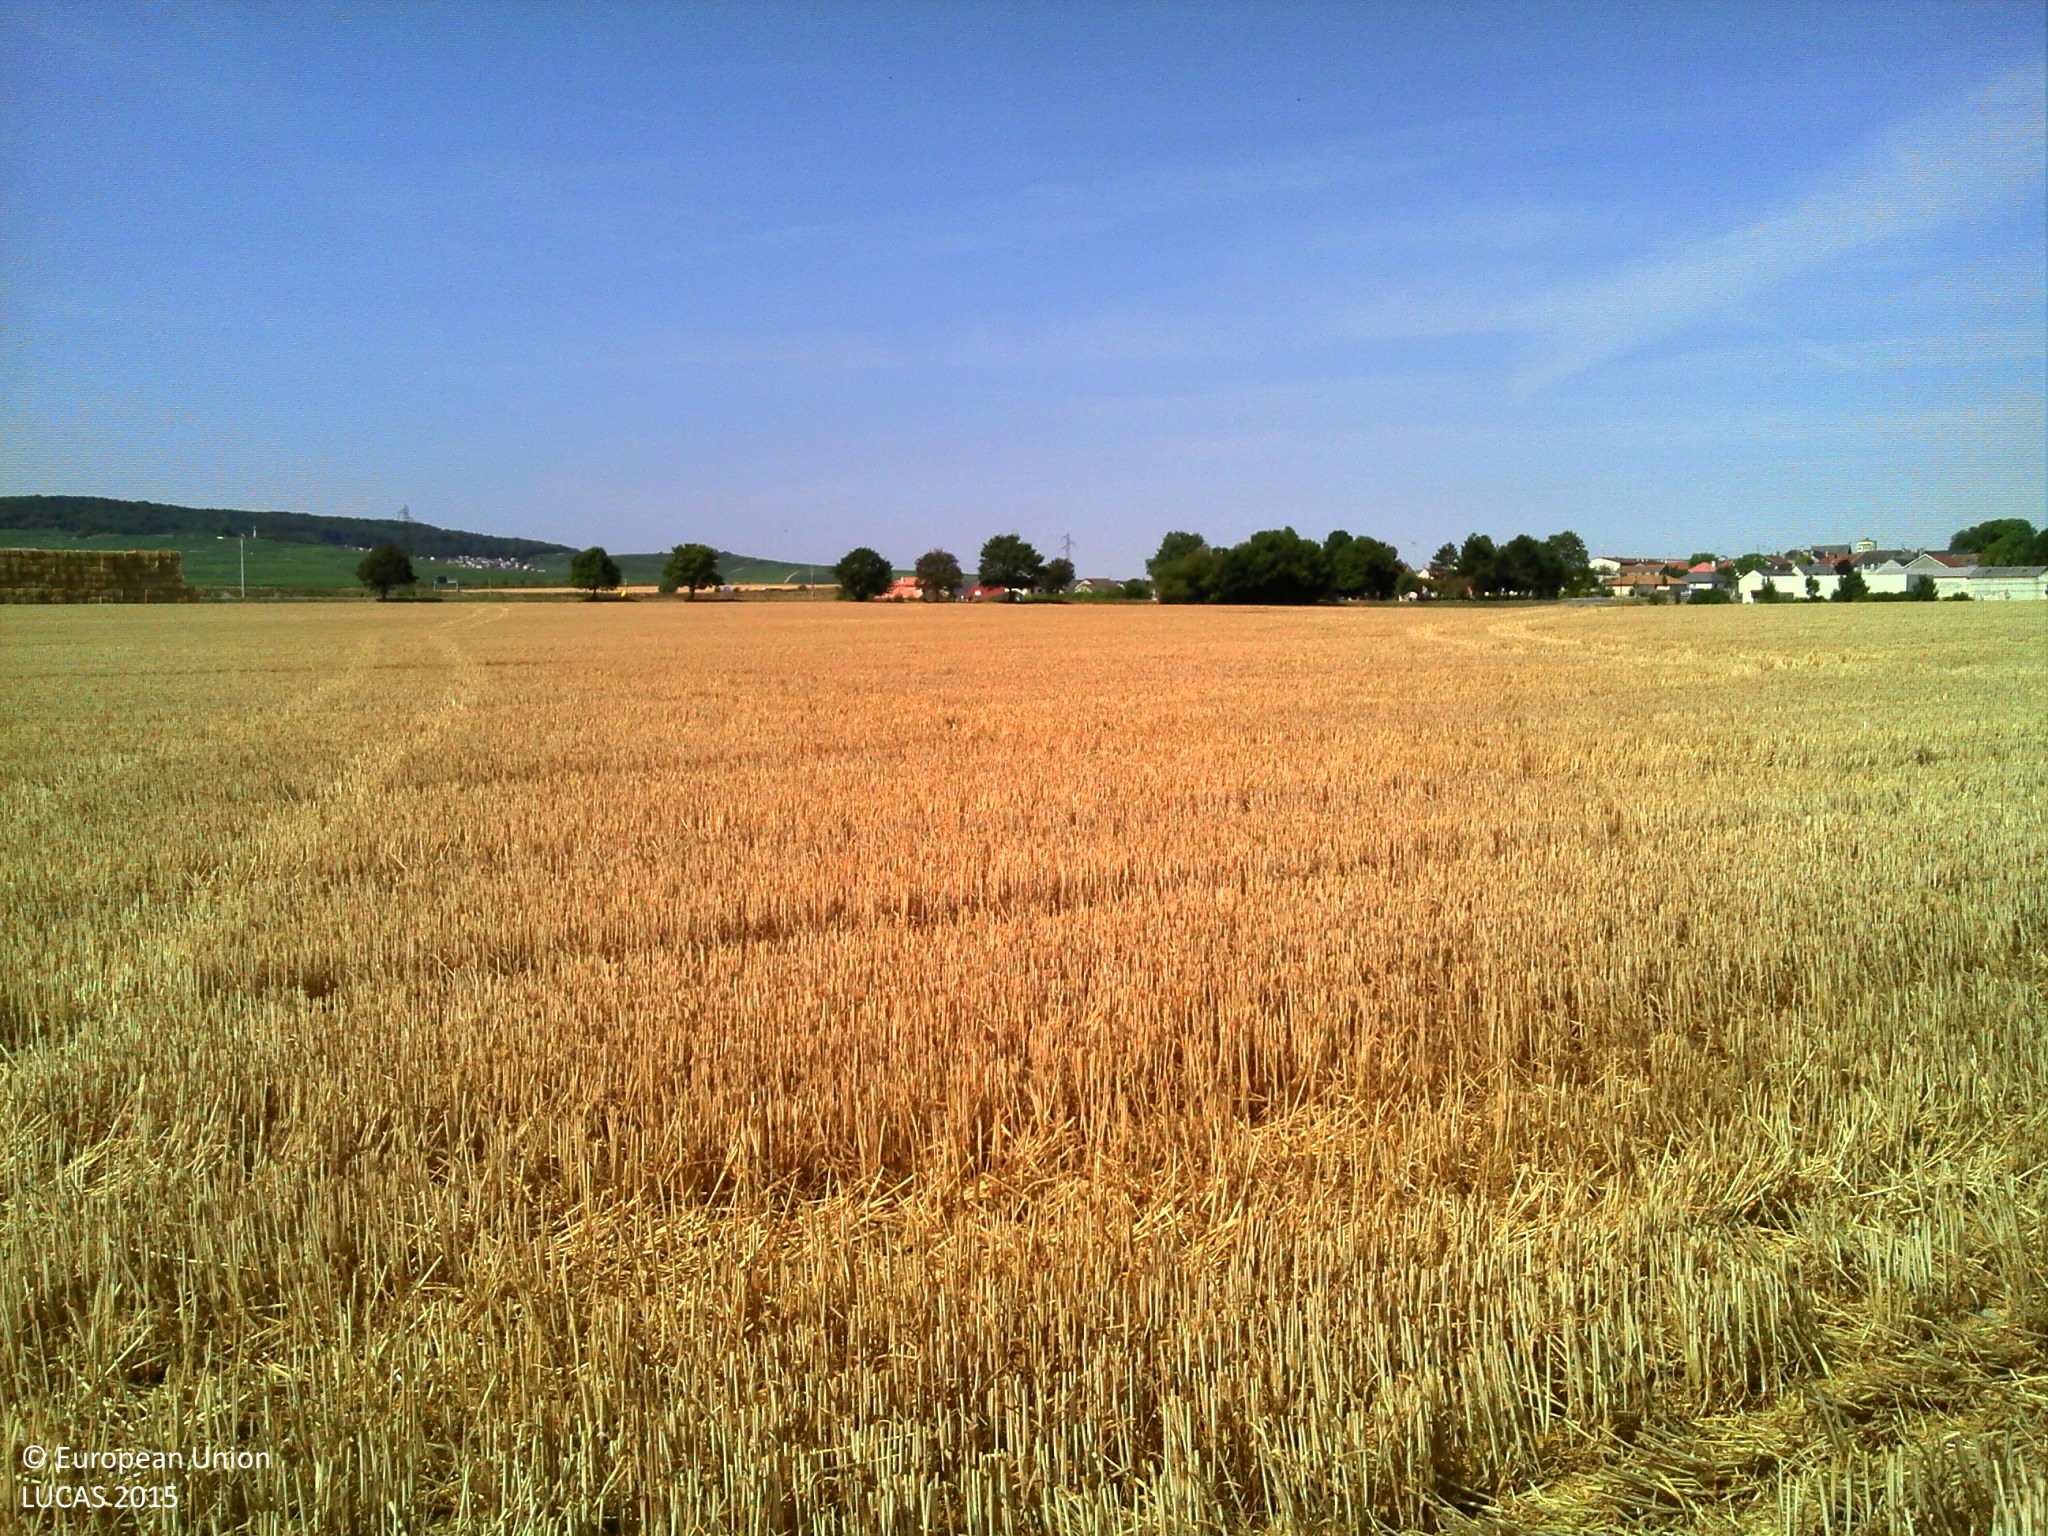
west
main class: Cropland
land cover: Common wheat
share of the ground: > 75 %
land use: Agriculture (excluding fallow land and kitchen gardens)
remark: Harvested field
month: August
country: FR
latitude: 49.1708
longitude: 4.1938
